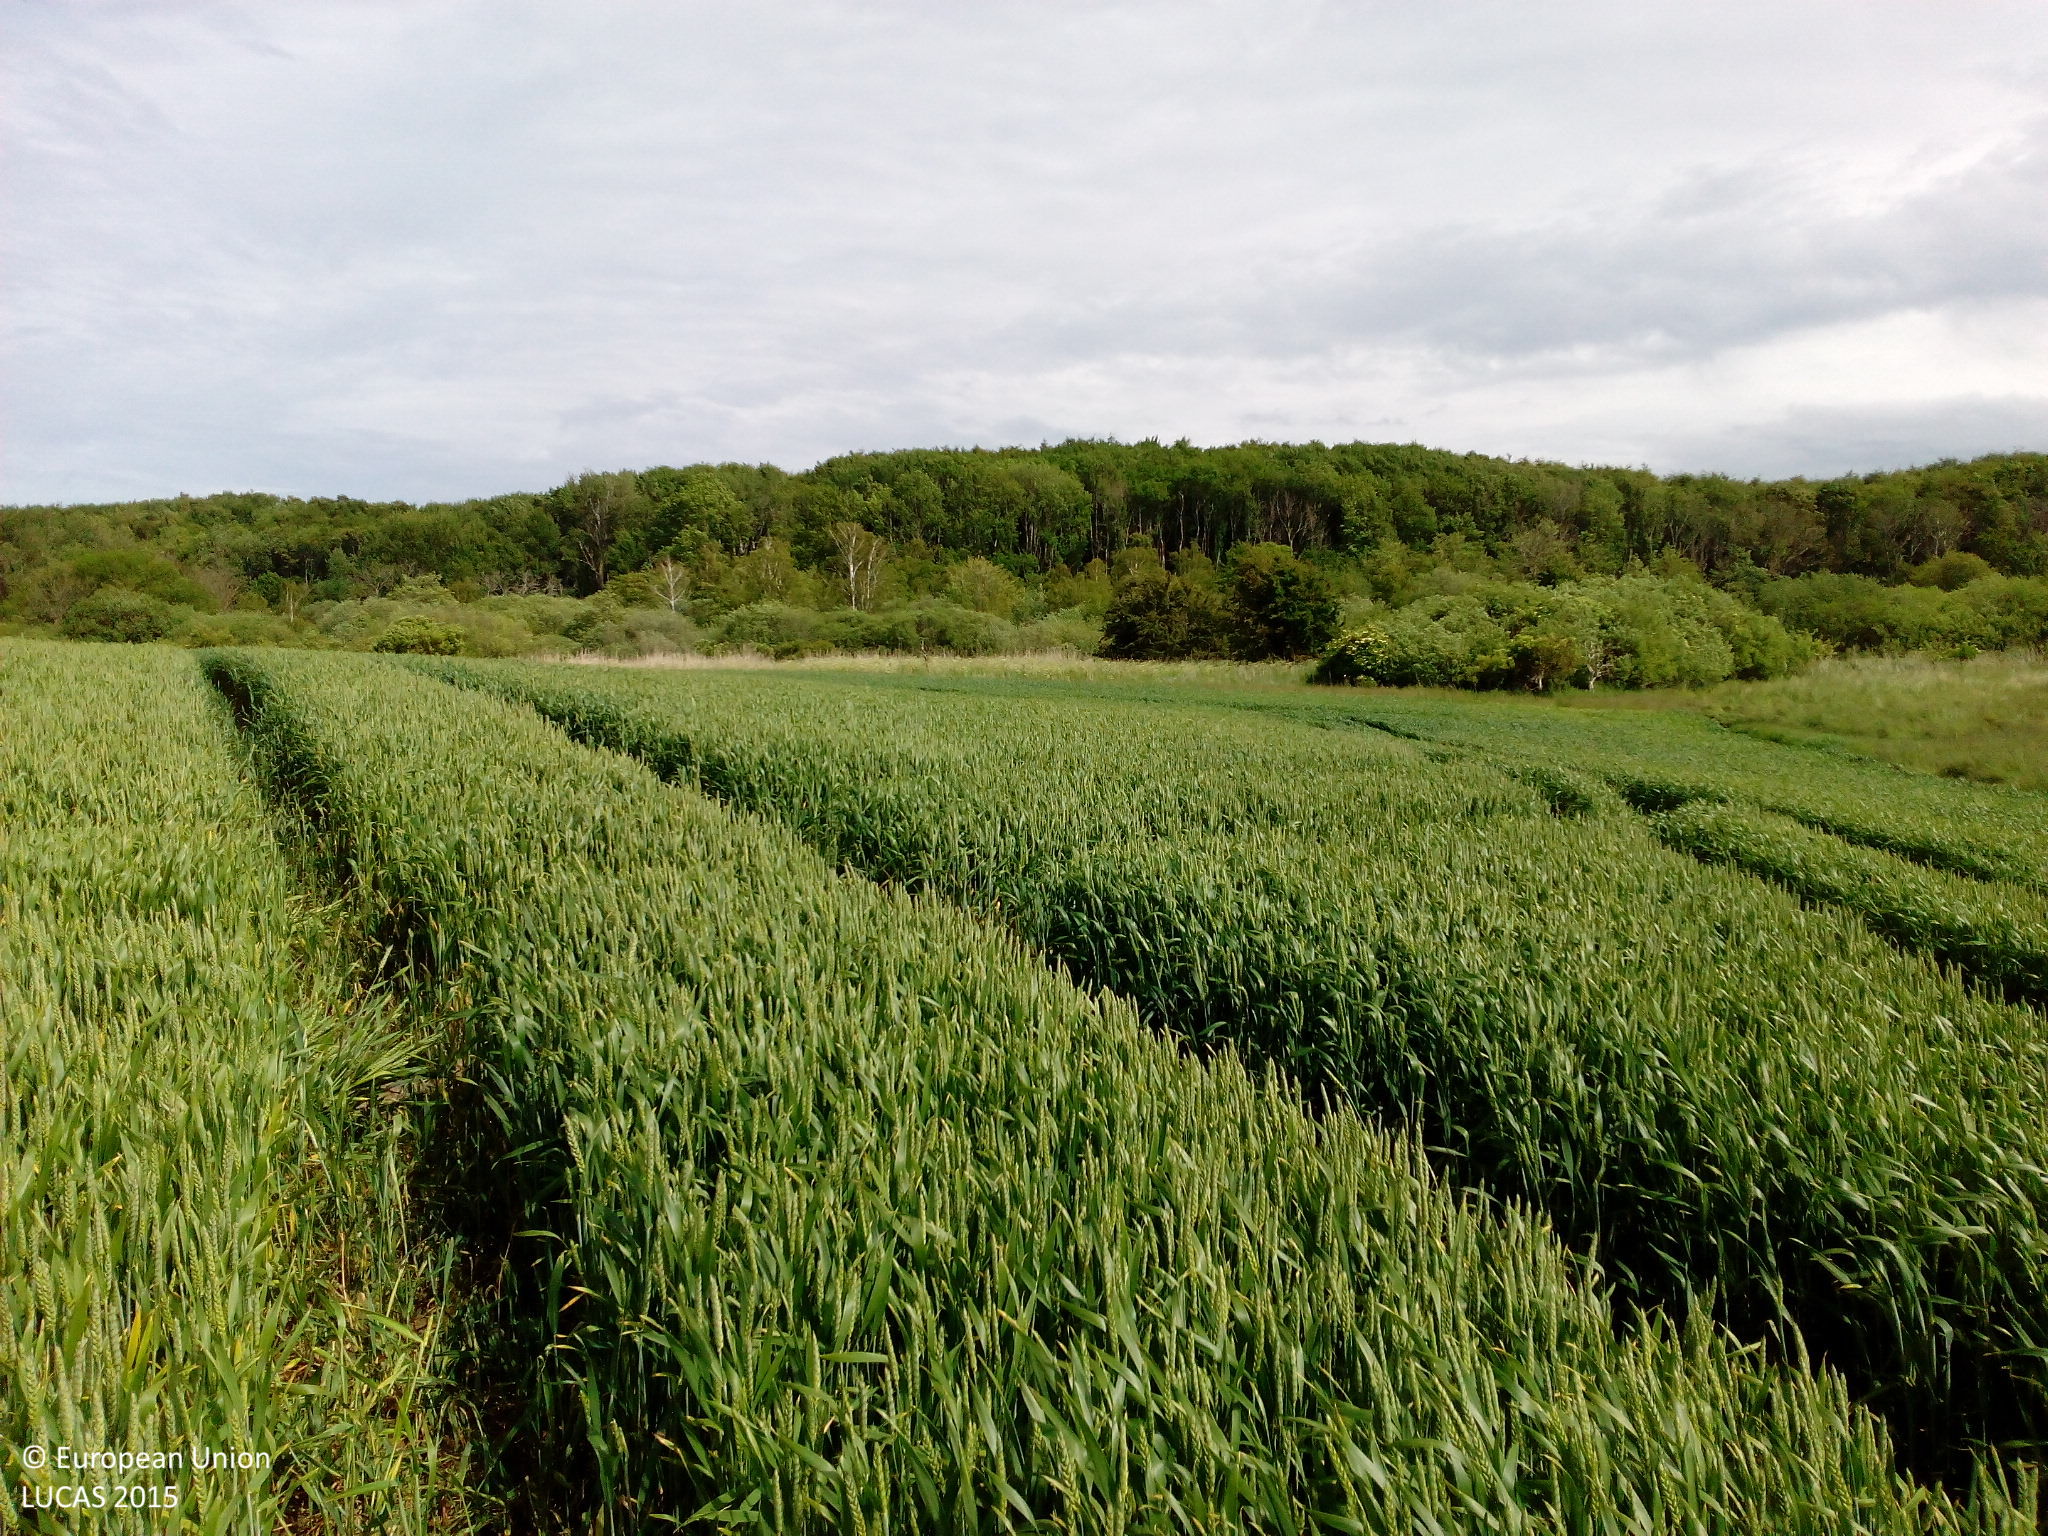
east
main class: Cropland
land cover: Common wheat
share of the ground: > 75 %
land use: Agriculture (excluding fallow land and kitchen gardens)
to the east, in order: Common wheat; Grassland without tree/shrub cover; Ditches and canals; Spontaneously vegetated surfaces; Inland marshes; Broadleaved woodland
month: June
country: DK
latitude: 54.9807
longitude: 10.8275
